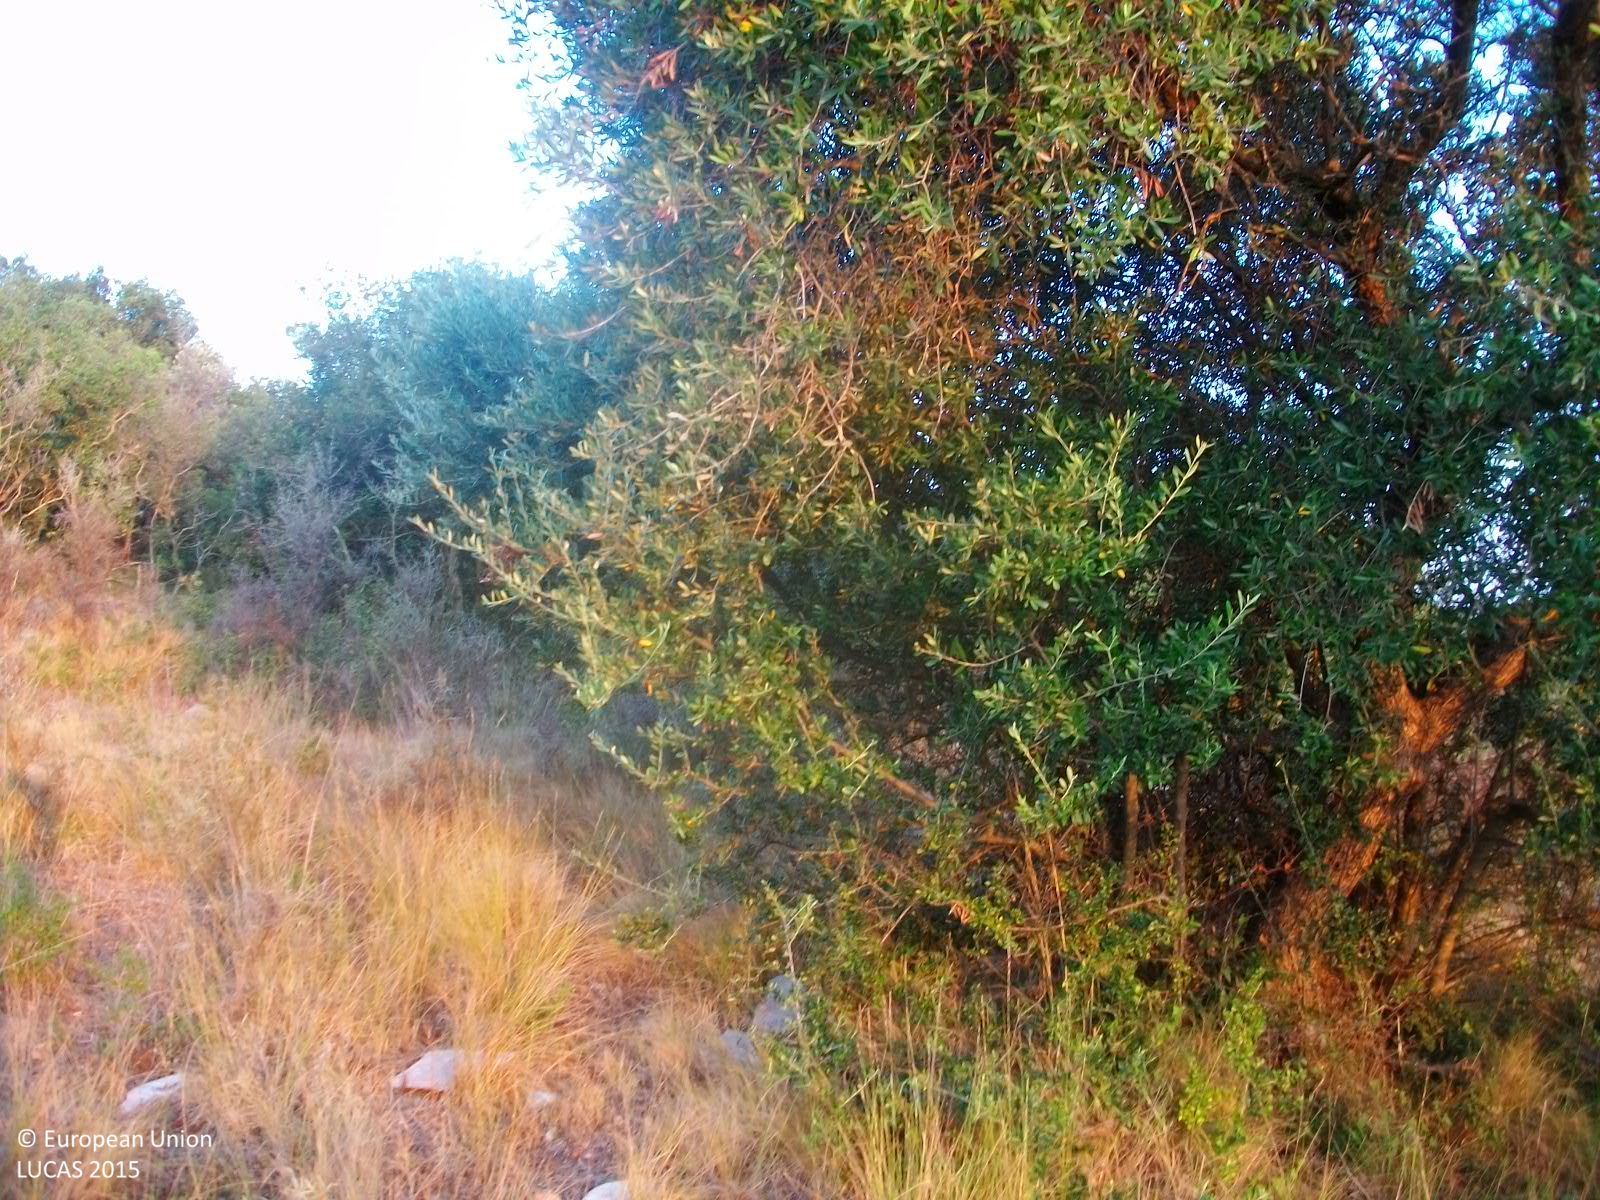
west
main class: Shrubland
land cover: Shrubland without tree cover
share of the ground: 25 - 50 %
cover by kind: herbaceous plants 70 %, shrubs 30 %
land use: Semi-natural and natural areas not in use
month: August
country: GR
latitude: 37.2696
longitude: 21.9206
